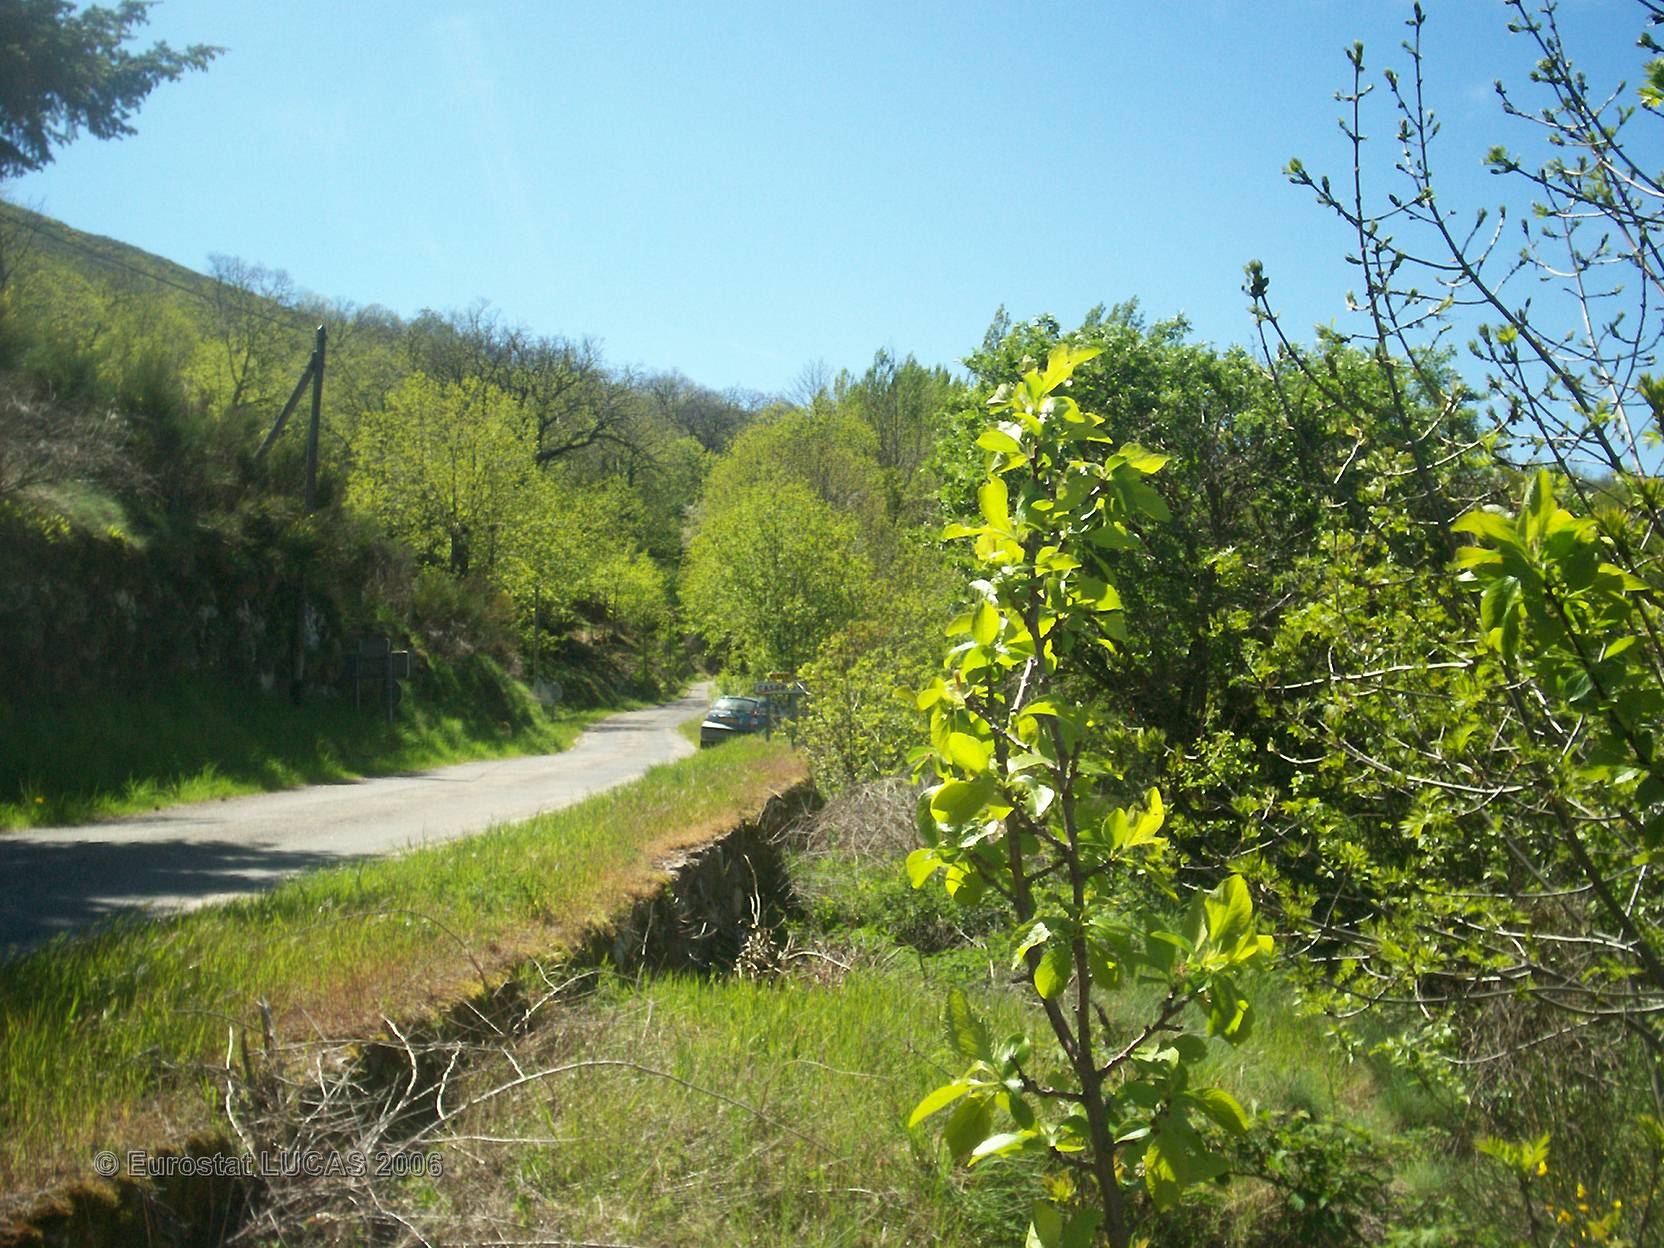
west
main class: Grassland
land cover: Grassland with sparse tree/shrub cover
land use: Unused
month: May
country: FR
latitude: 44.0517
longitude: 3.4290
